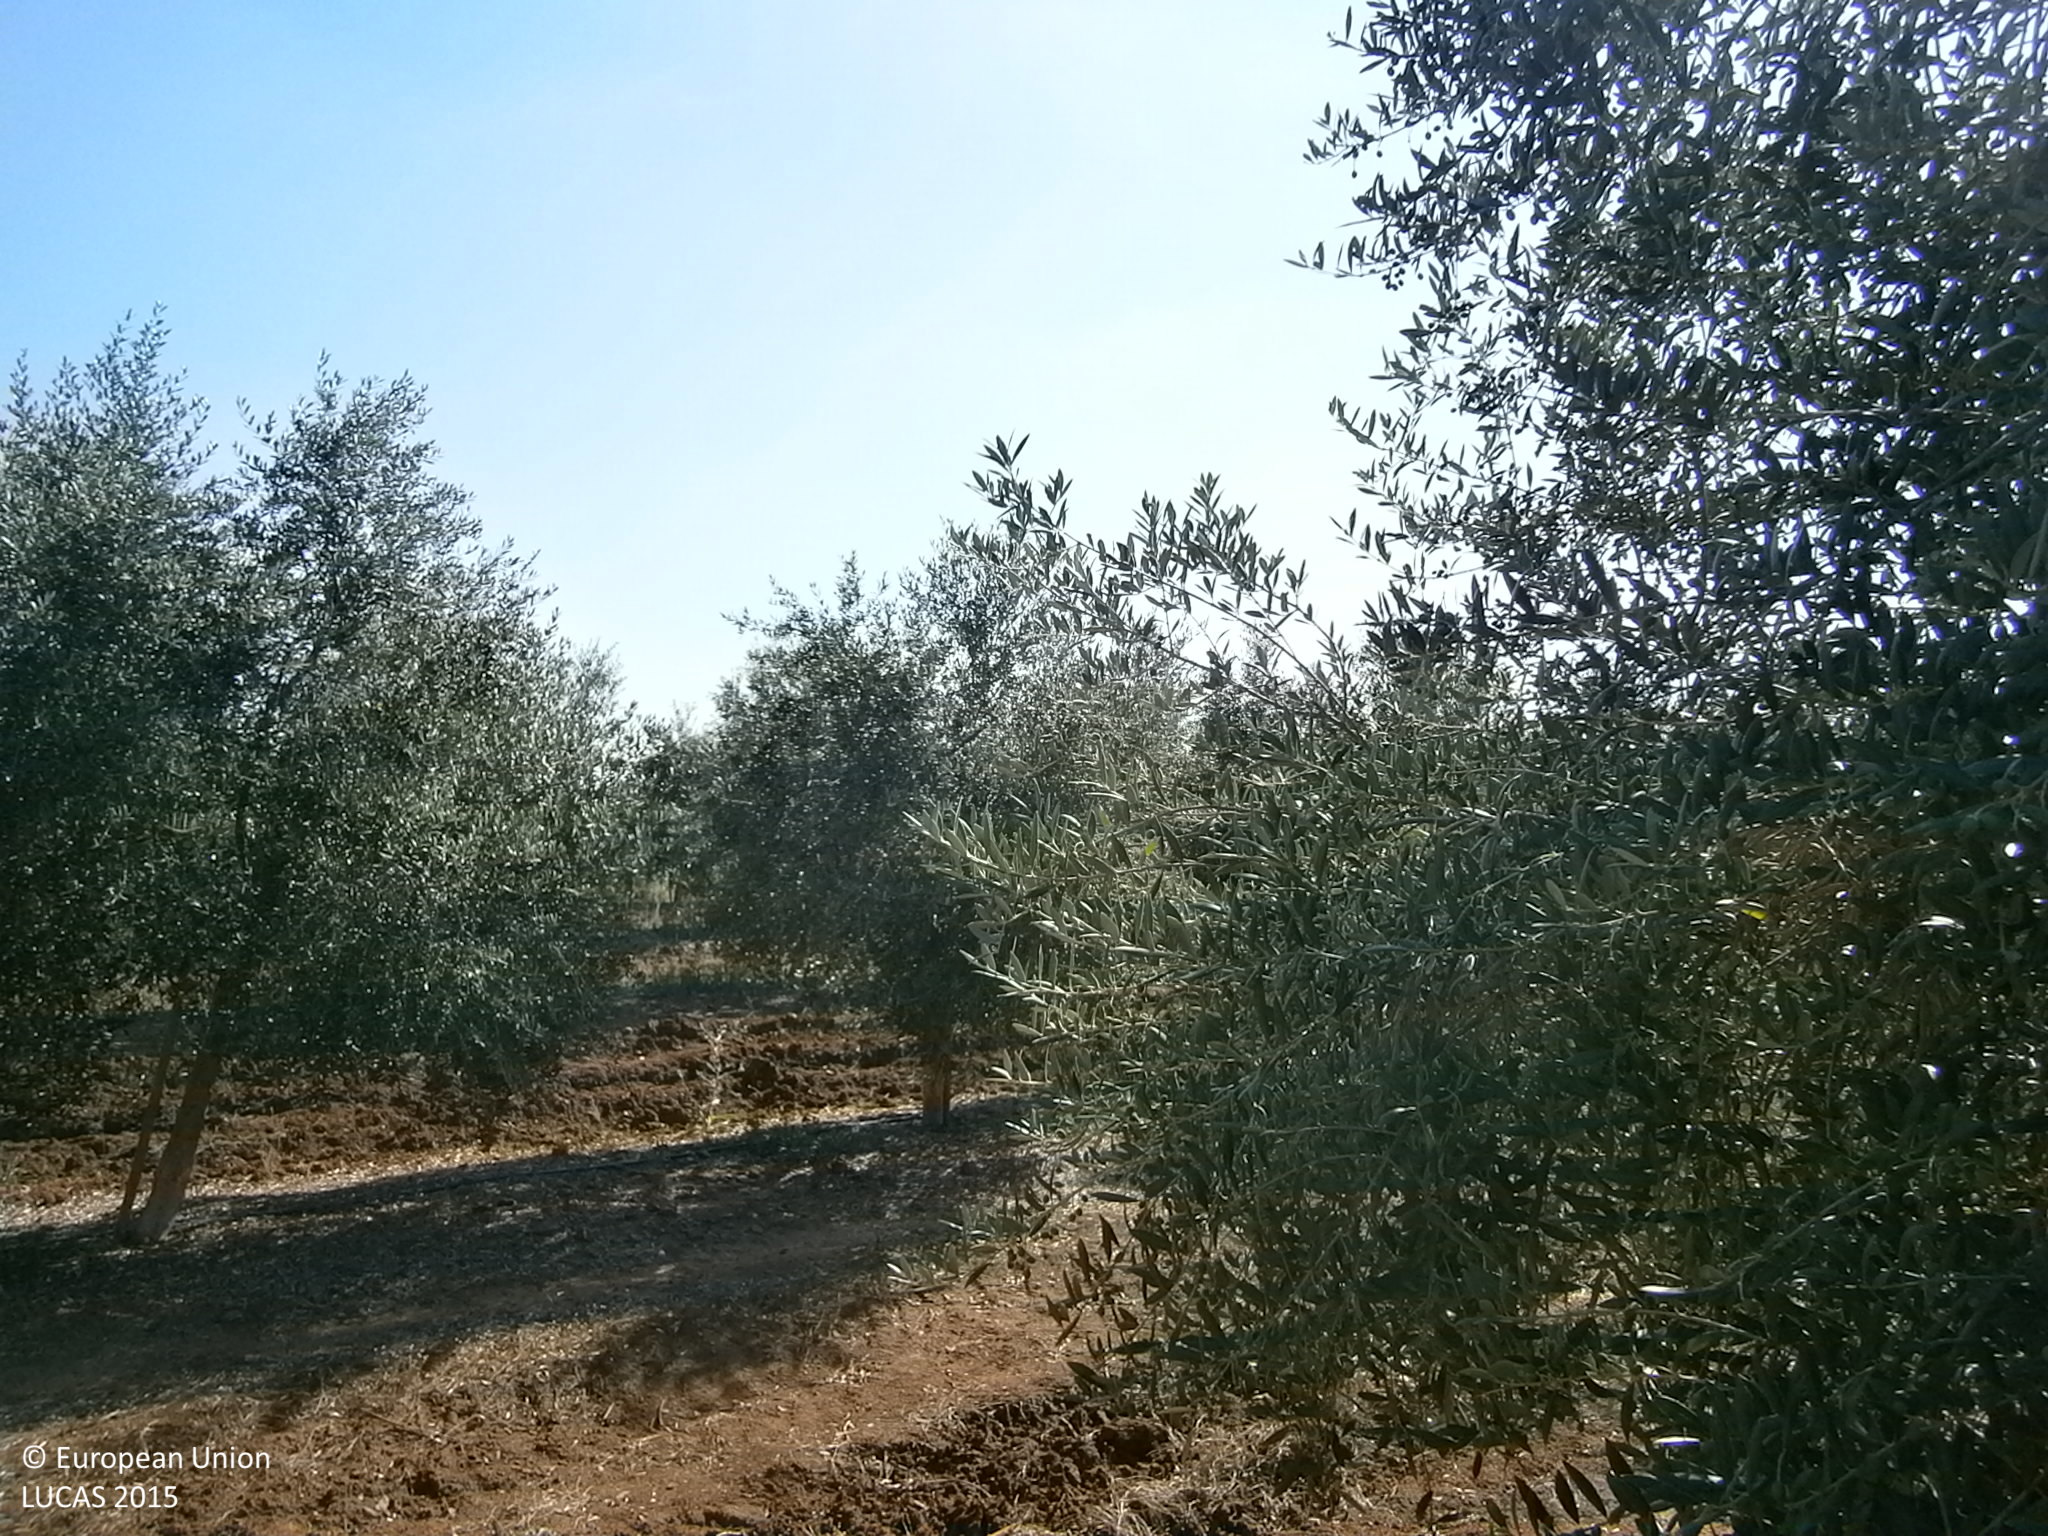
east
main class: Cropland
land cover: Olive groves
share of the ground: 25 - 50 %
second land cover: Spontaneously vegetated surfaces
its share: 10 - 25 %
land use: Agriculture (excluding fallow land and kitchen gardens)
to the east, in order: Olive groves; Spontaneously vegetated surfaces; Other bare soil; Shrubland with sparse tree cover; Rock outcrops; Shrubland with sparse tree cover; Olive groves
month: June
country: ES
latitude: 38.6777
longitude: -6.9045
